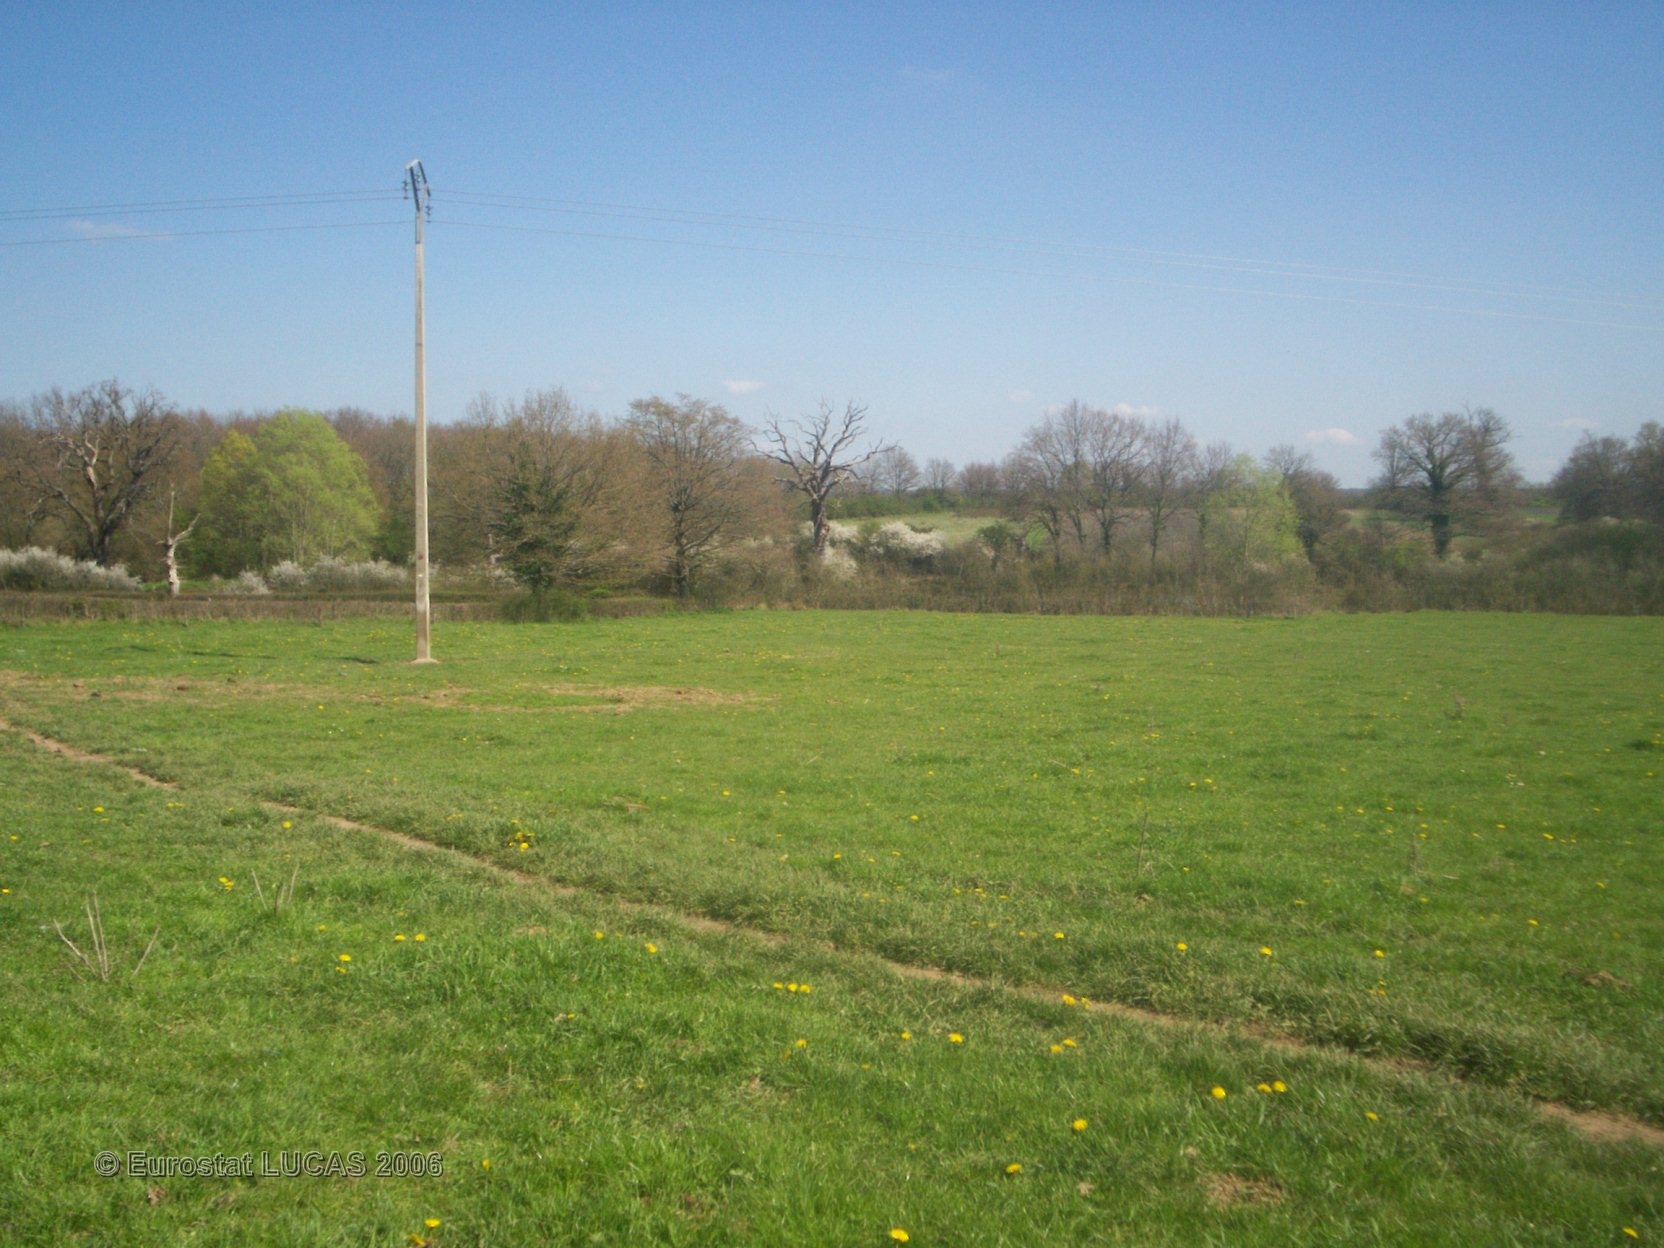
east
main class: Grassland
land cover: Grassland without tree/shrub cover
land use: Agriculture (excluding fallow land and kitchen gardens)
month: April
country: FR
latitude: 46.6189
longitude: 3.1415
